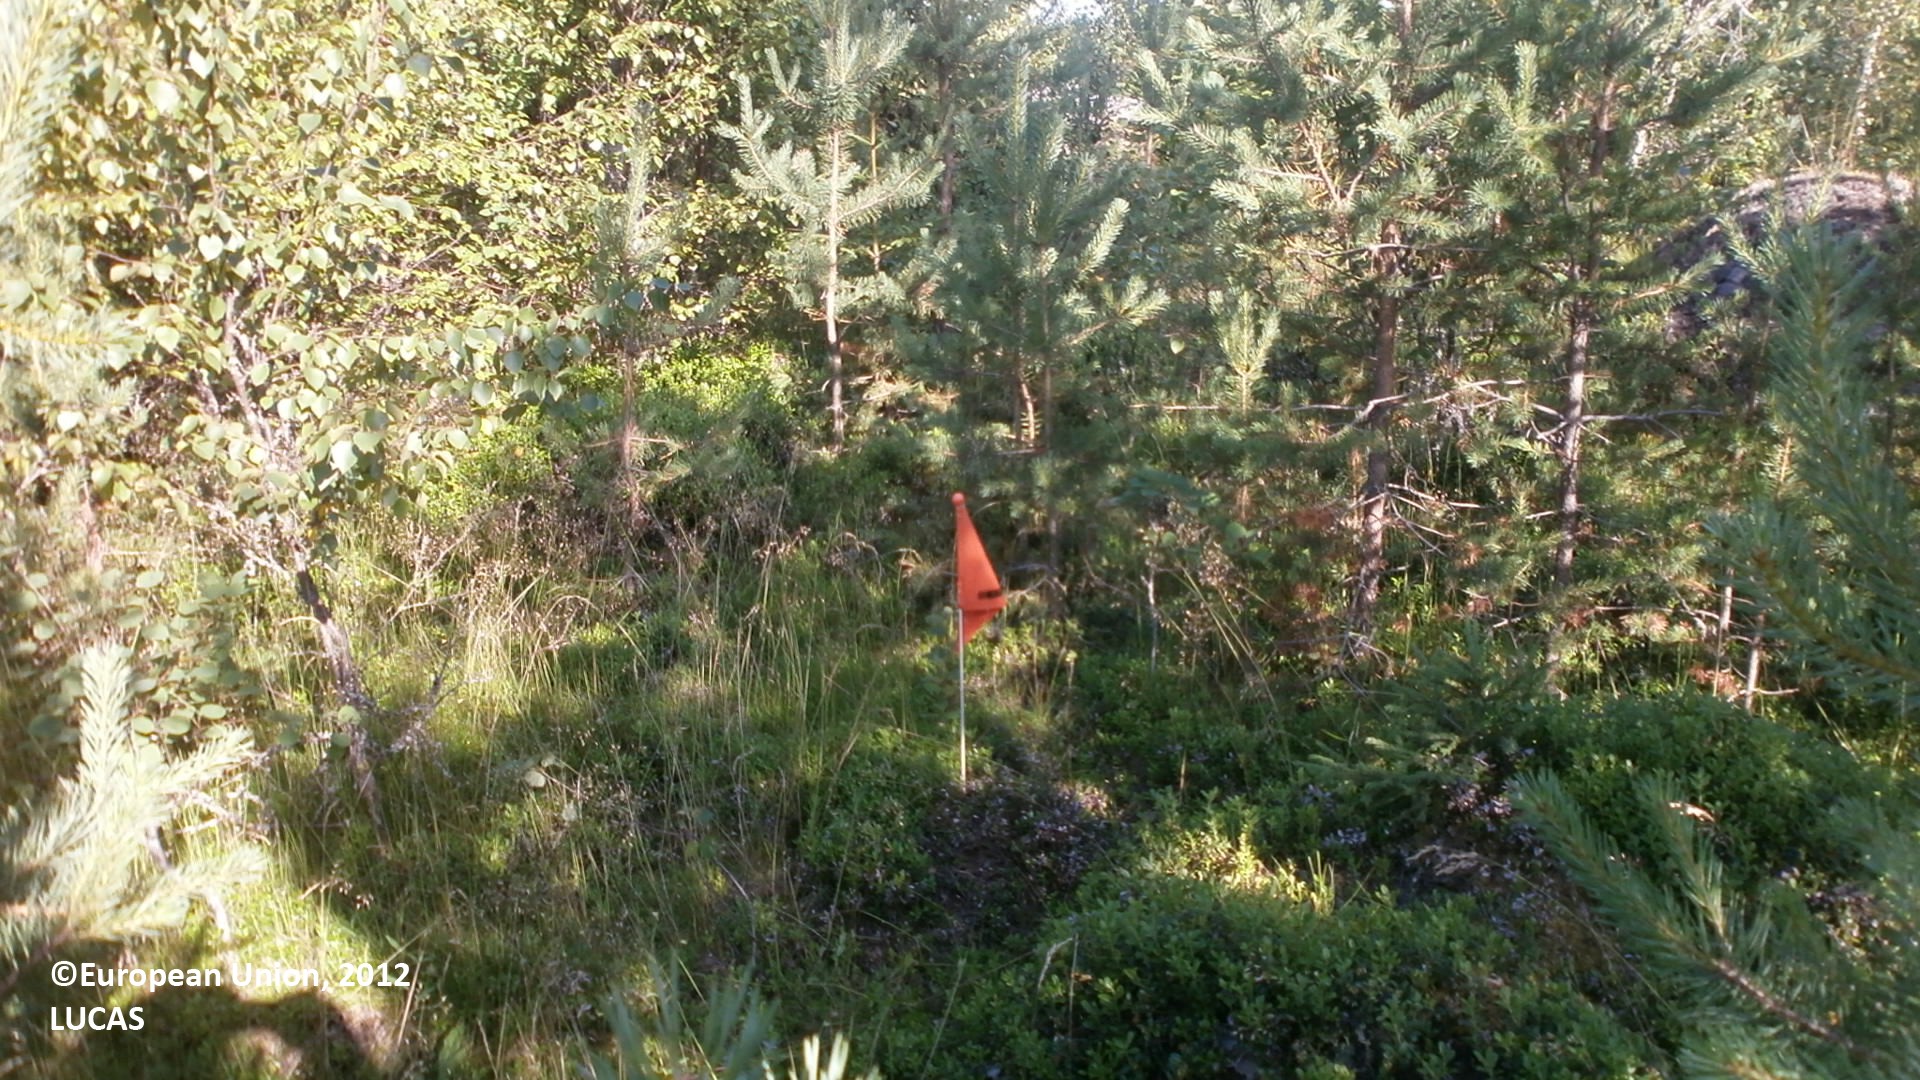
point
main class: Woodland
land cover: Pine dominated mixed woodland
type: boreal forest
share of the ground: 50 - 75 %
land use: Forestry
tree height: > 5 m
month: July
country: FI
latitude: 64.0764
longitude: 24.1103
